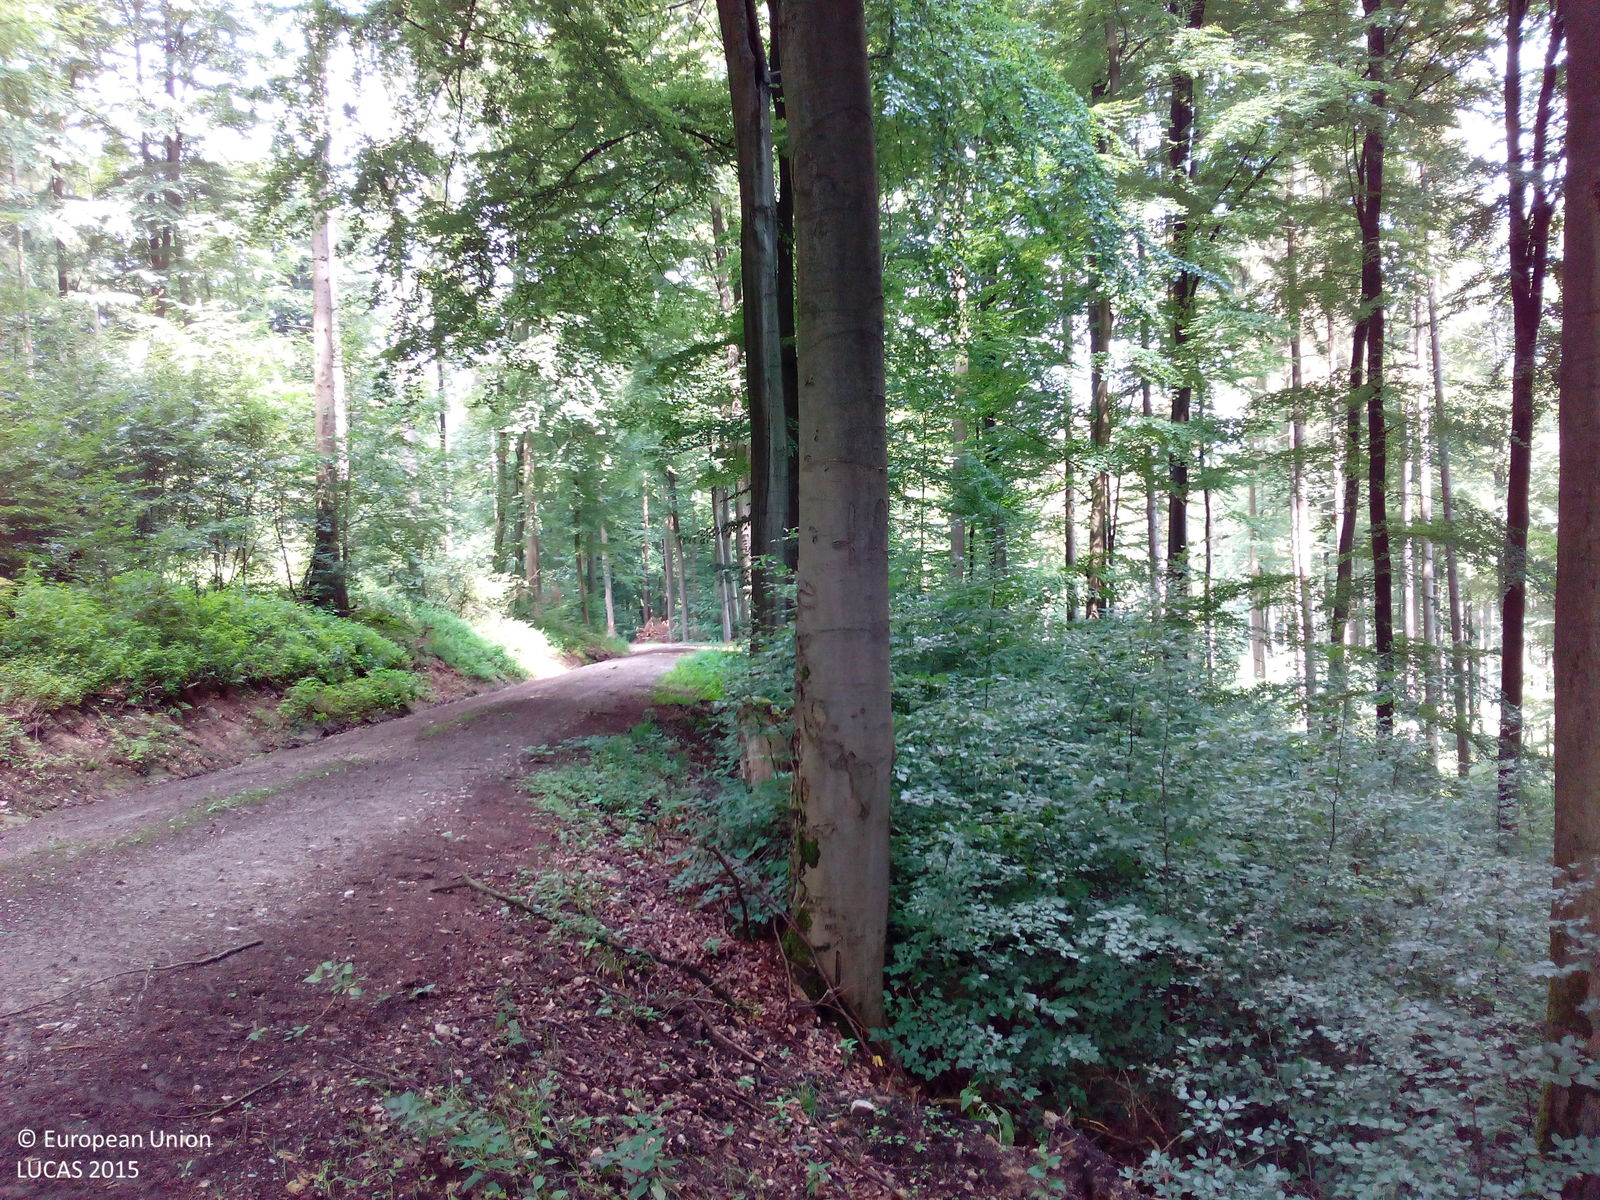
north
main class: Woodland
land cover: Spruce dominated mixed woodland
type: hemiboreal forest and nemoral coniferous forest and mixed broadleaved-coniferous forest
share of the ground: > 75 %
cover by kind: coniferous forest trees 75 %, broadleaved forest trees 25 %
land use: Forestry
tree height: > 5 m
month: July
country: DE
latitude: 51.9281
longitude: 9.9273
